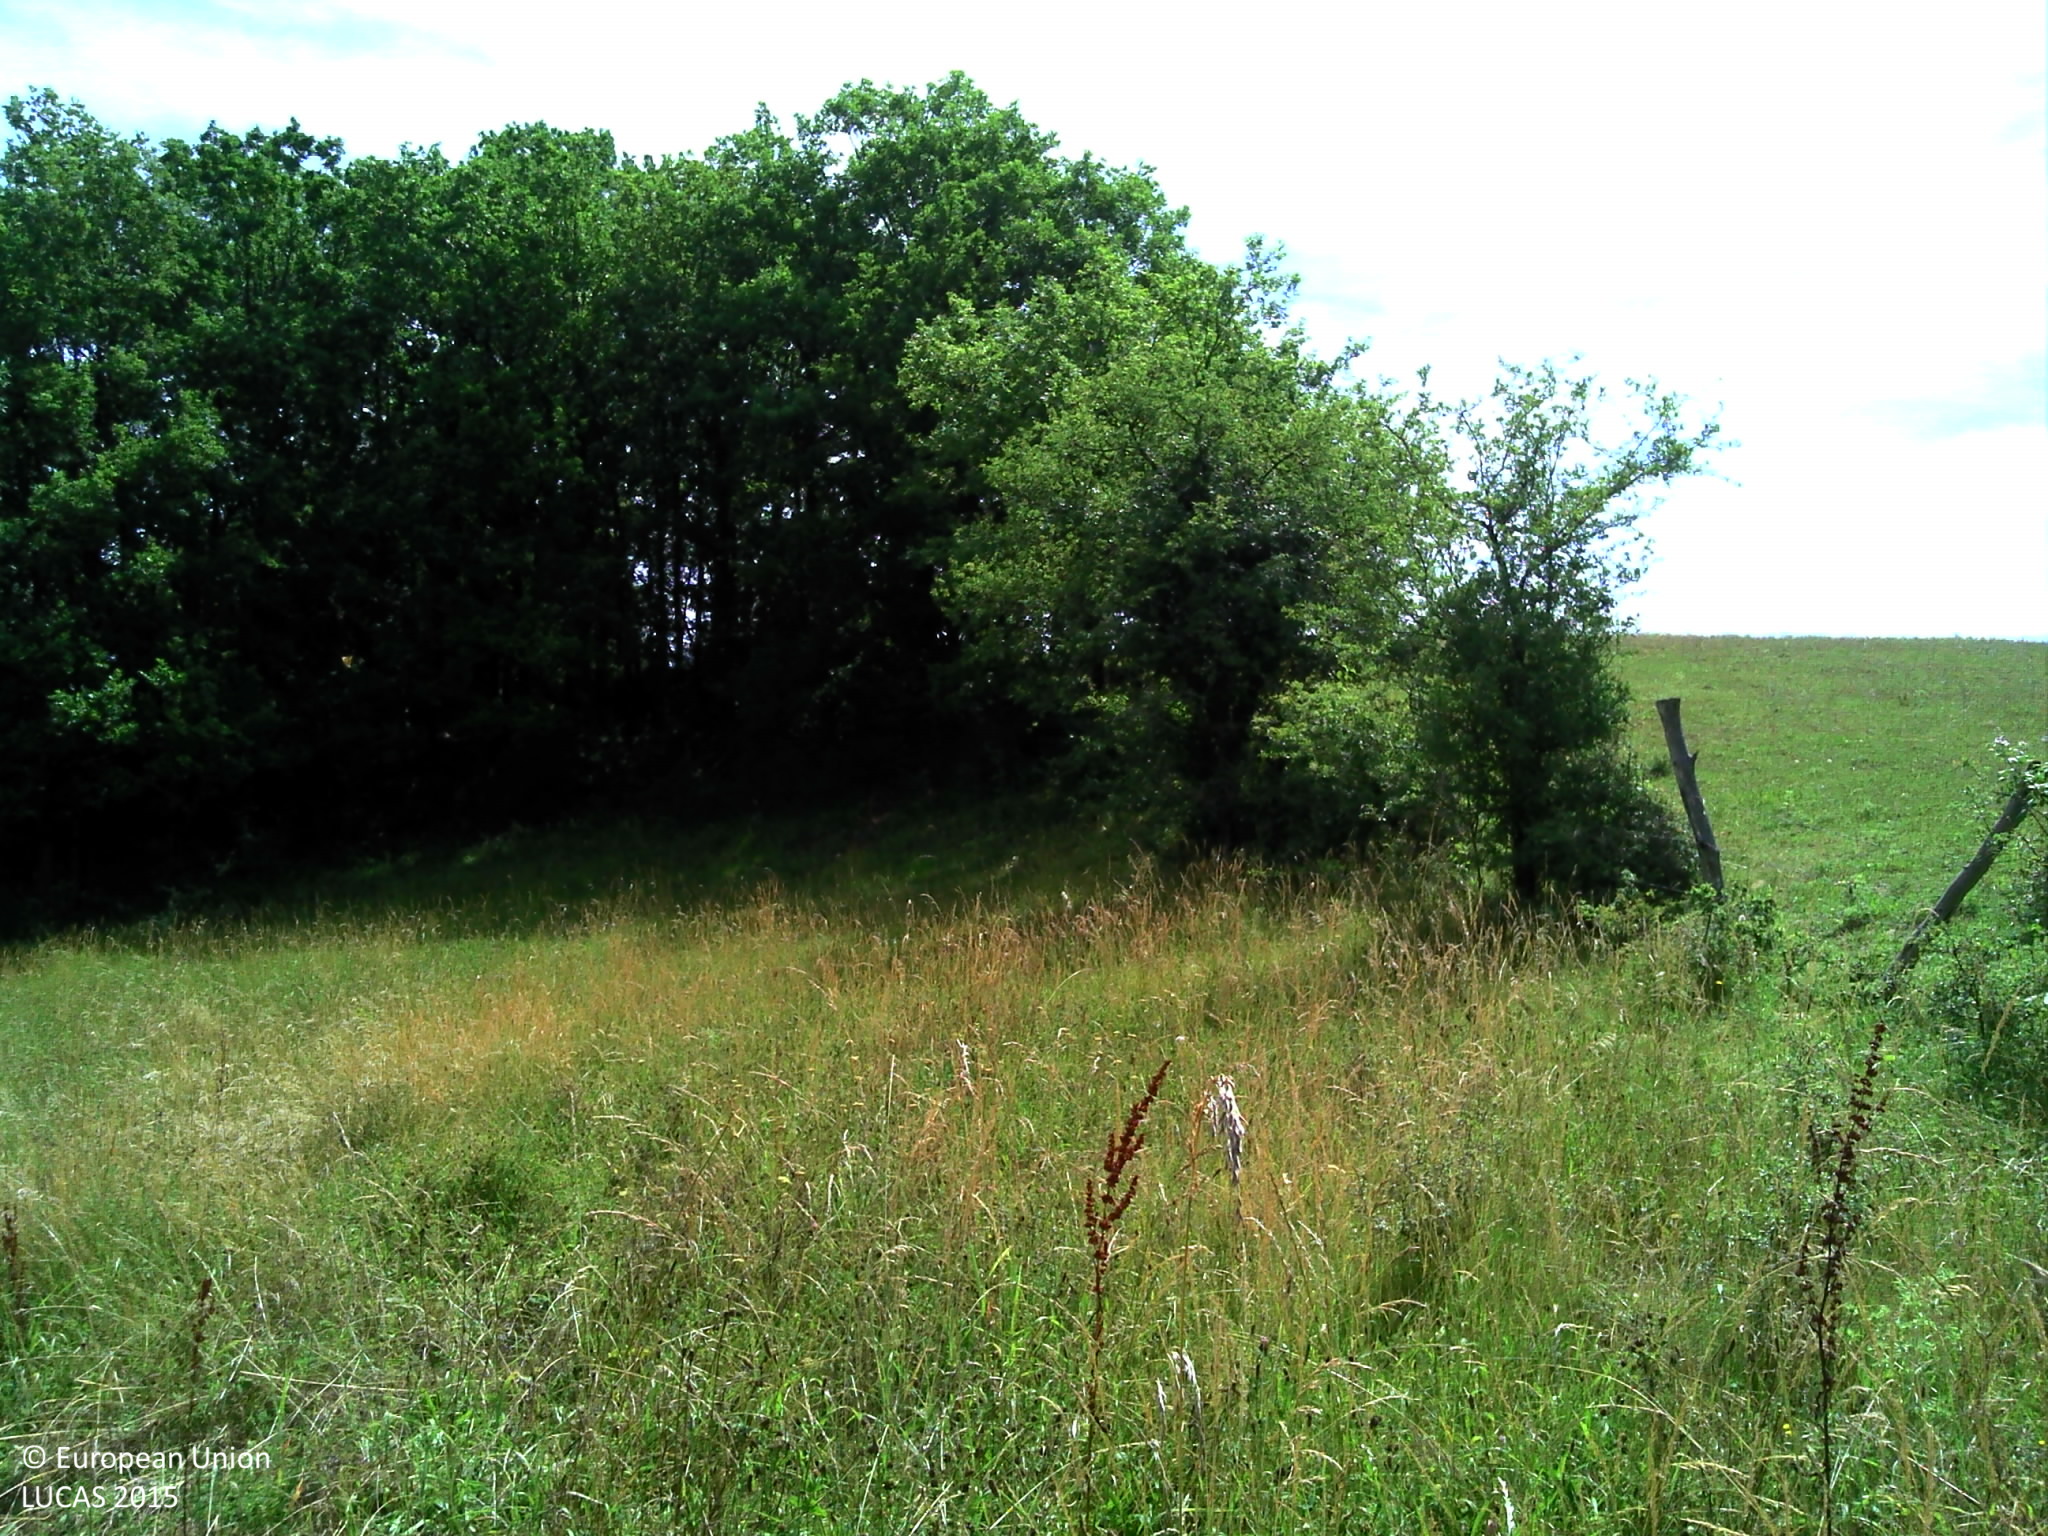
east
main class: Grassland
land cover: Grassland with sparse tree/shrub cover
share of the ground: > 75 %
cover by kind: herbaceous plants 95 %, broadleaved forest trees 5 %
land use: Agriculture (excluding fallow land and kitchen gardens)
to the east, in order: Grassland with sparse tree/shrub cover; Broadleaved woodland; Fences; Grassland without tree/shrub cover; Fences; Ditches and canals; Grass margins; Tracks; Spontaneously vegetated surfaces; Ditches and canals; Broadleaved woodland
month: June
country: FR
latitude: 44.5312
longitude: 2.0098
